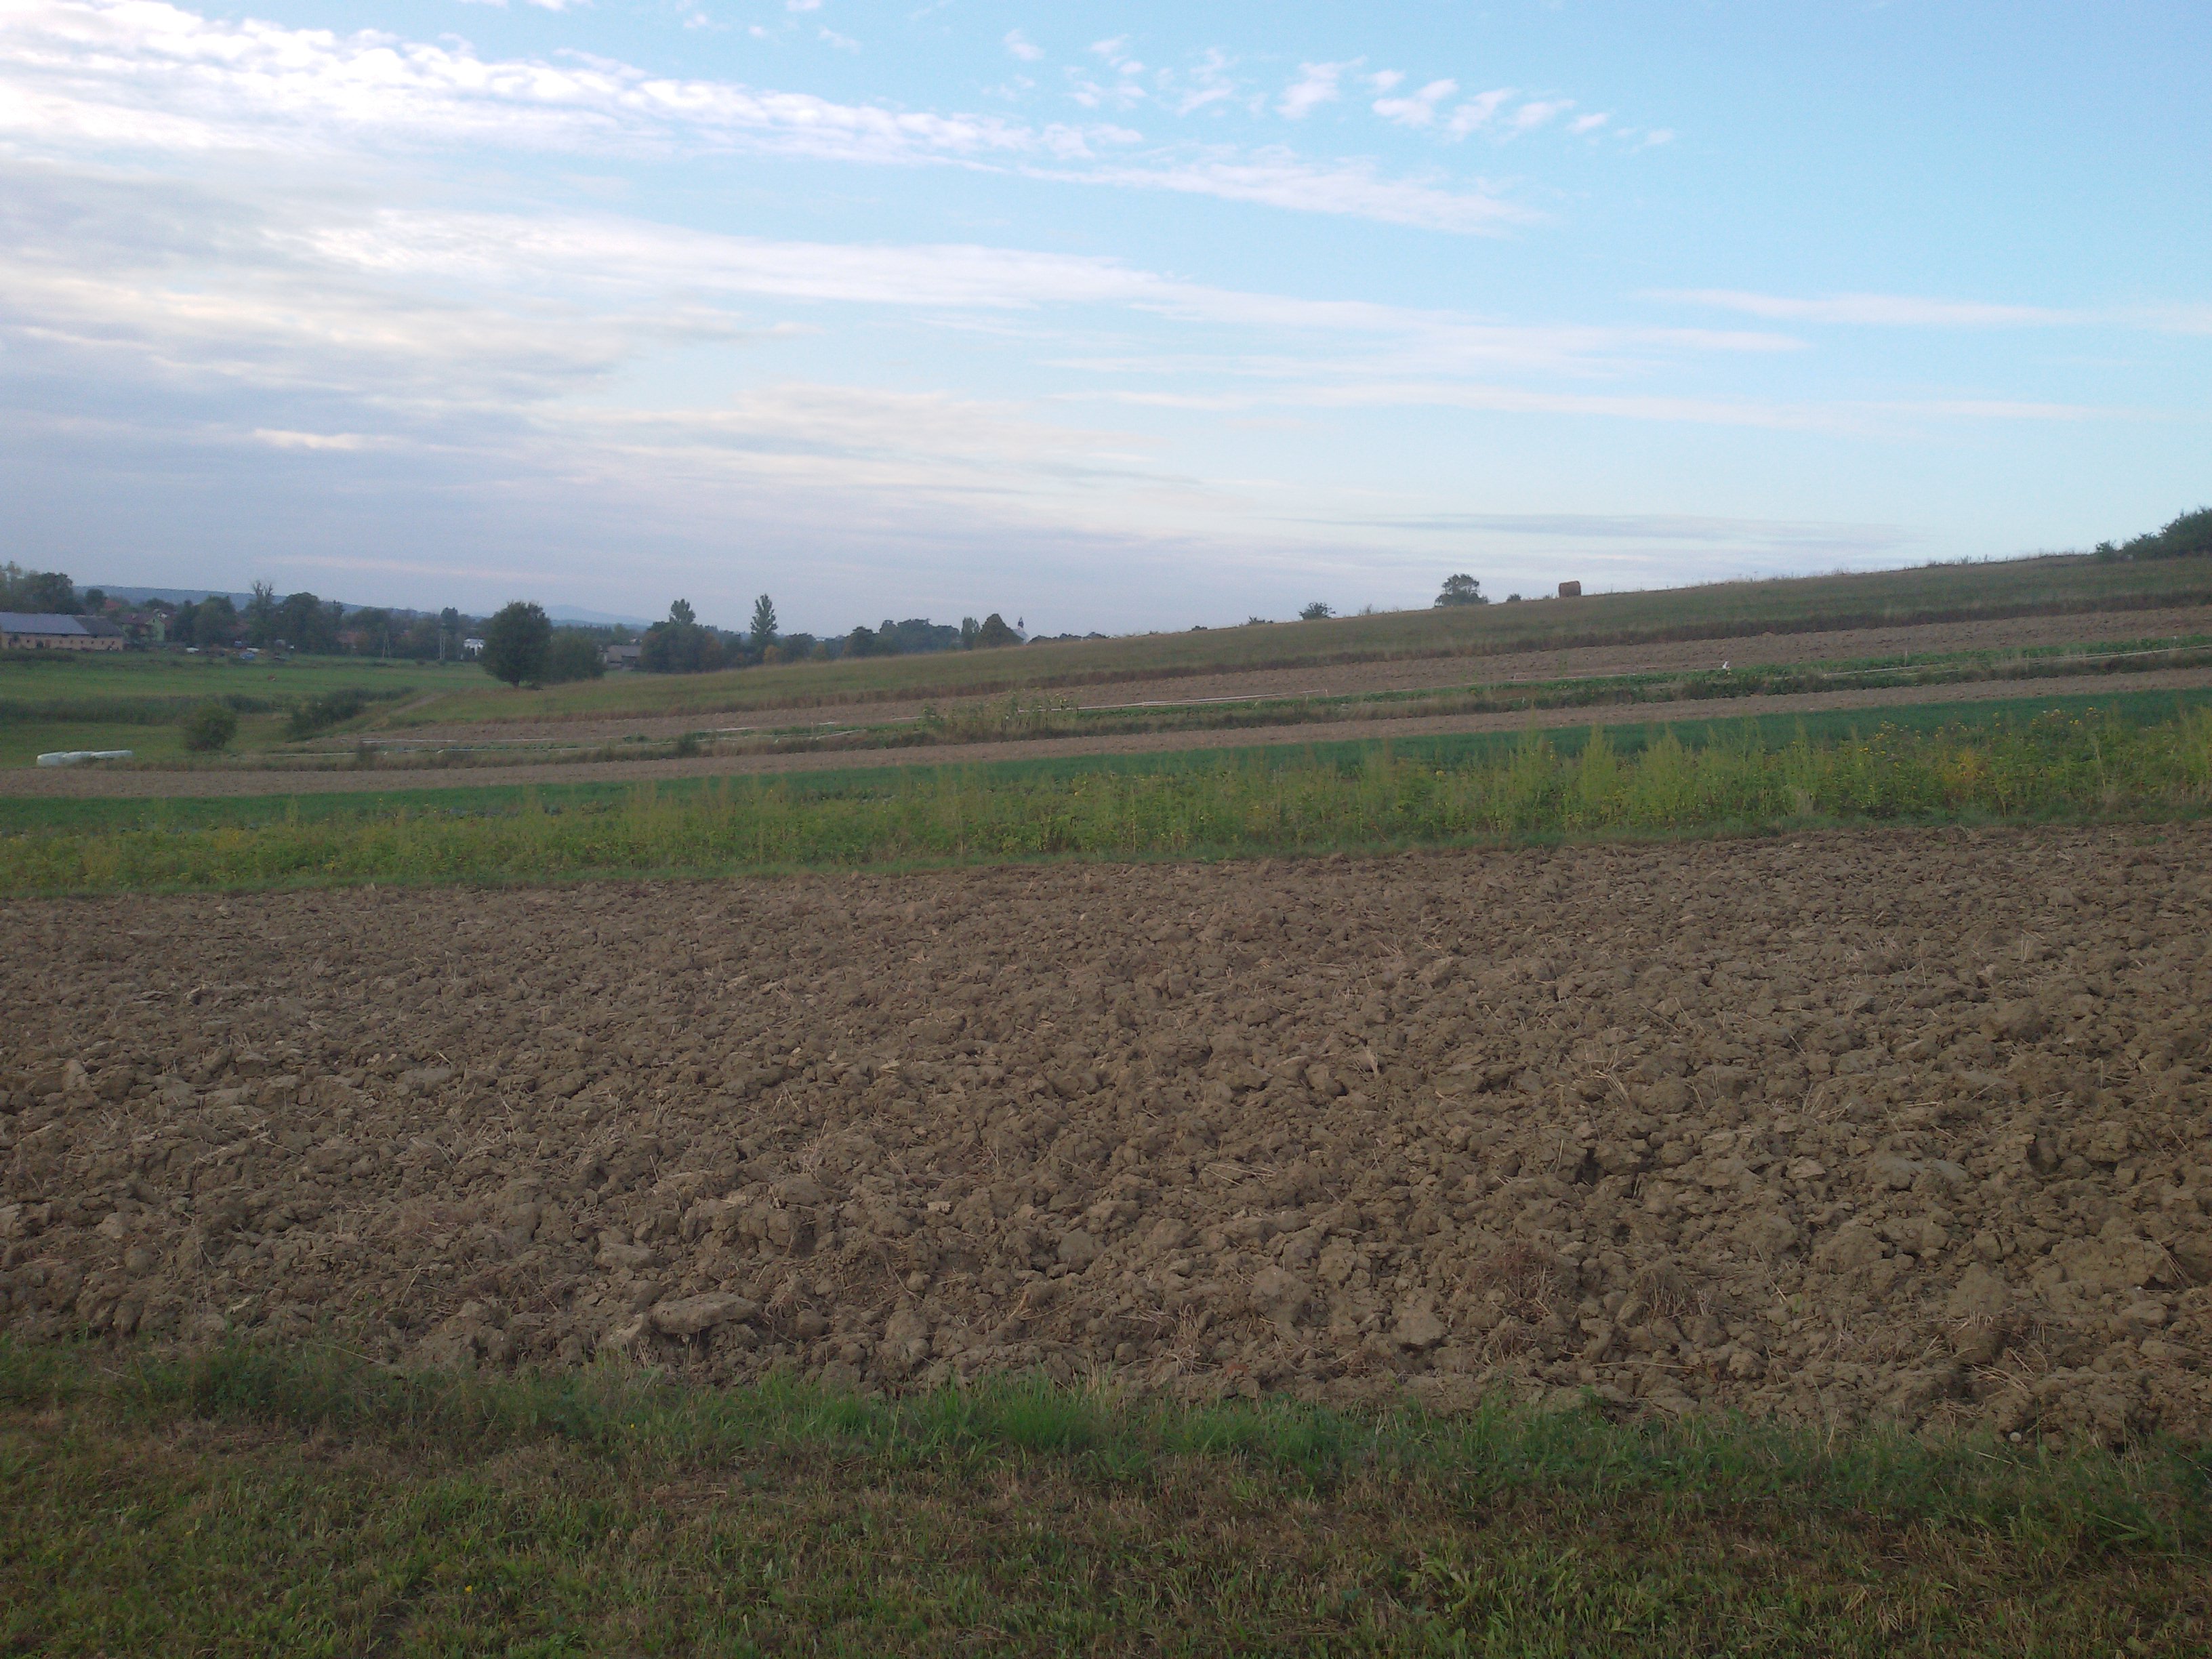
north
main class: Grassland
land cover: Grassland without tree/shrub cover
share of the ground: > 75 %
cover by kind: herbaceous plants 100 %
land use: Agriculture (excluding fallow land and kitchen gardens)
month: September
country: PL
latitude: 49.6187
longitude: 21.4966
